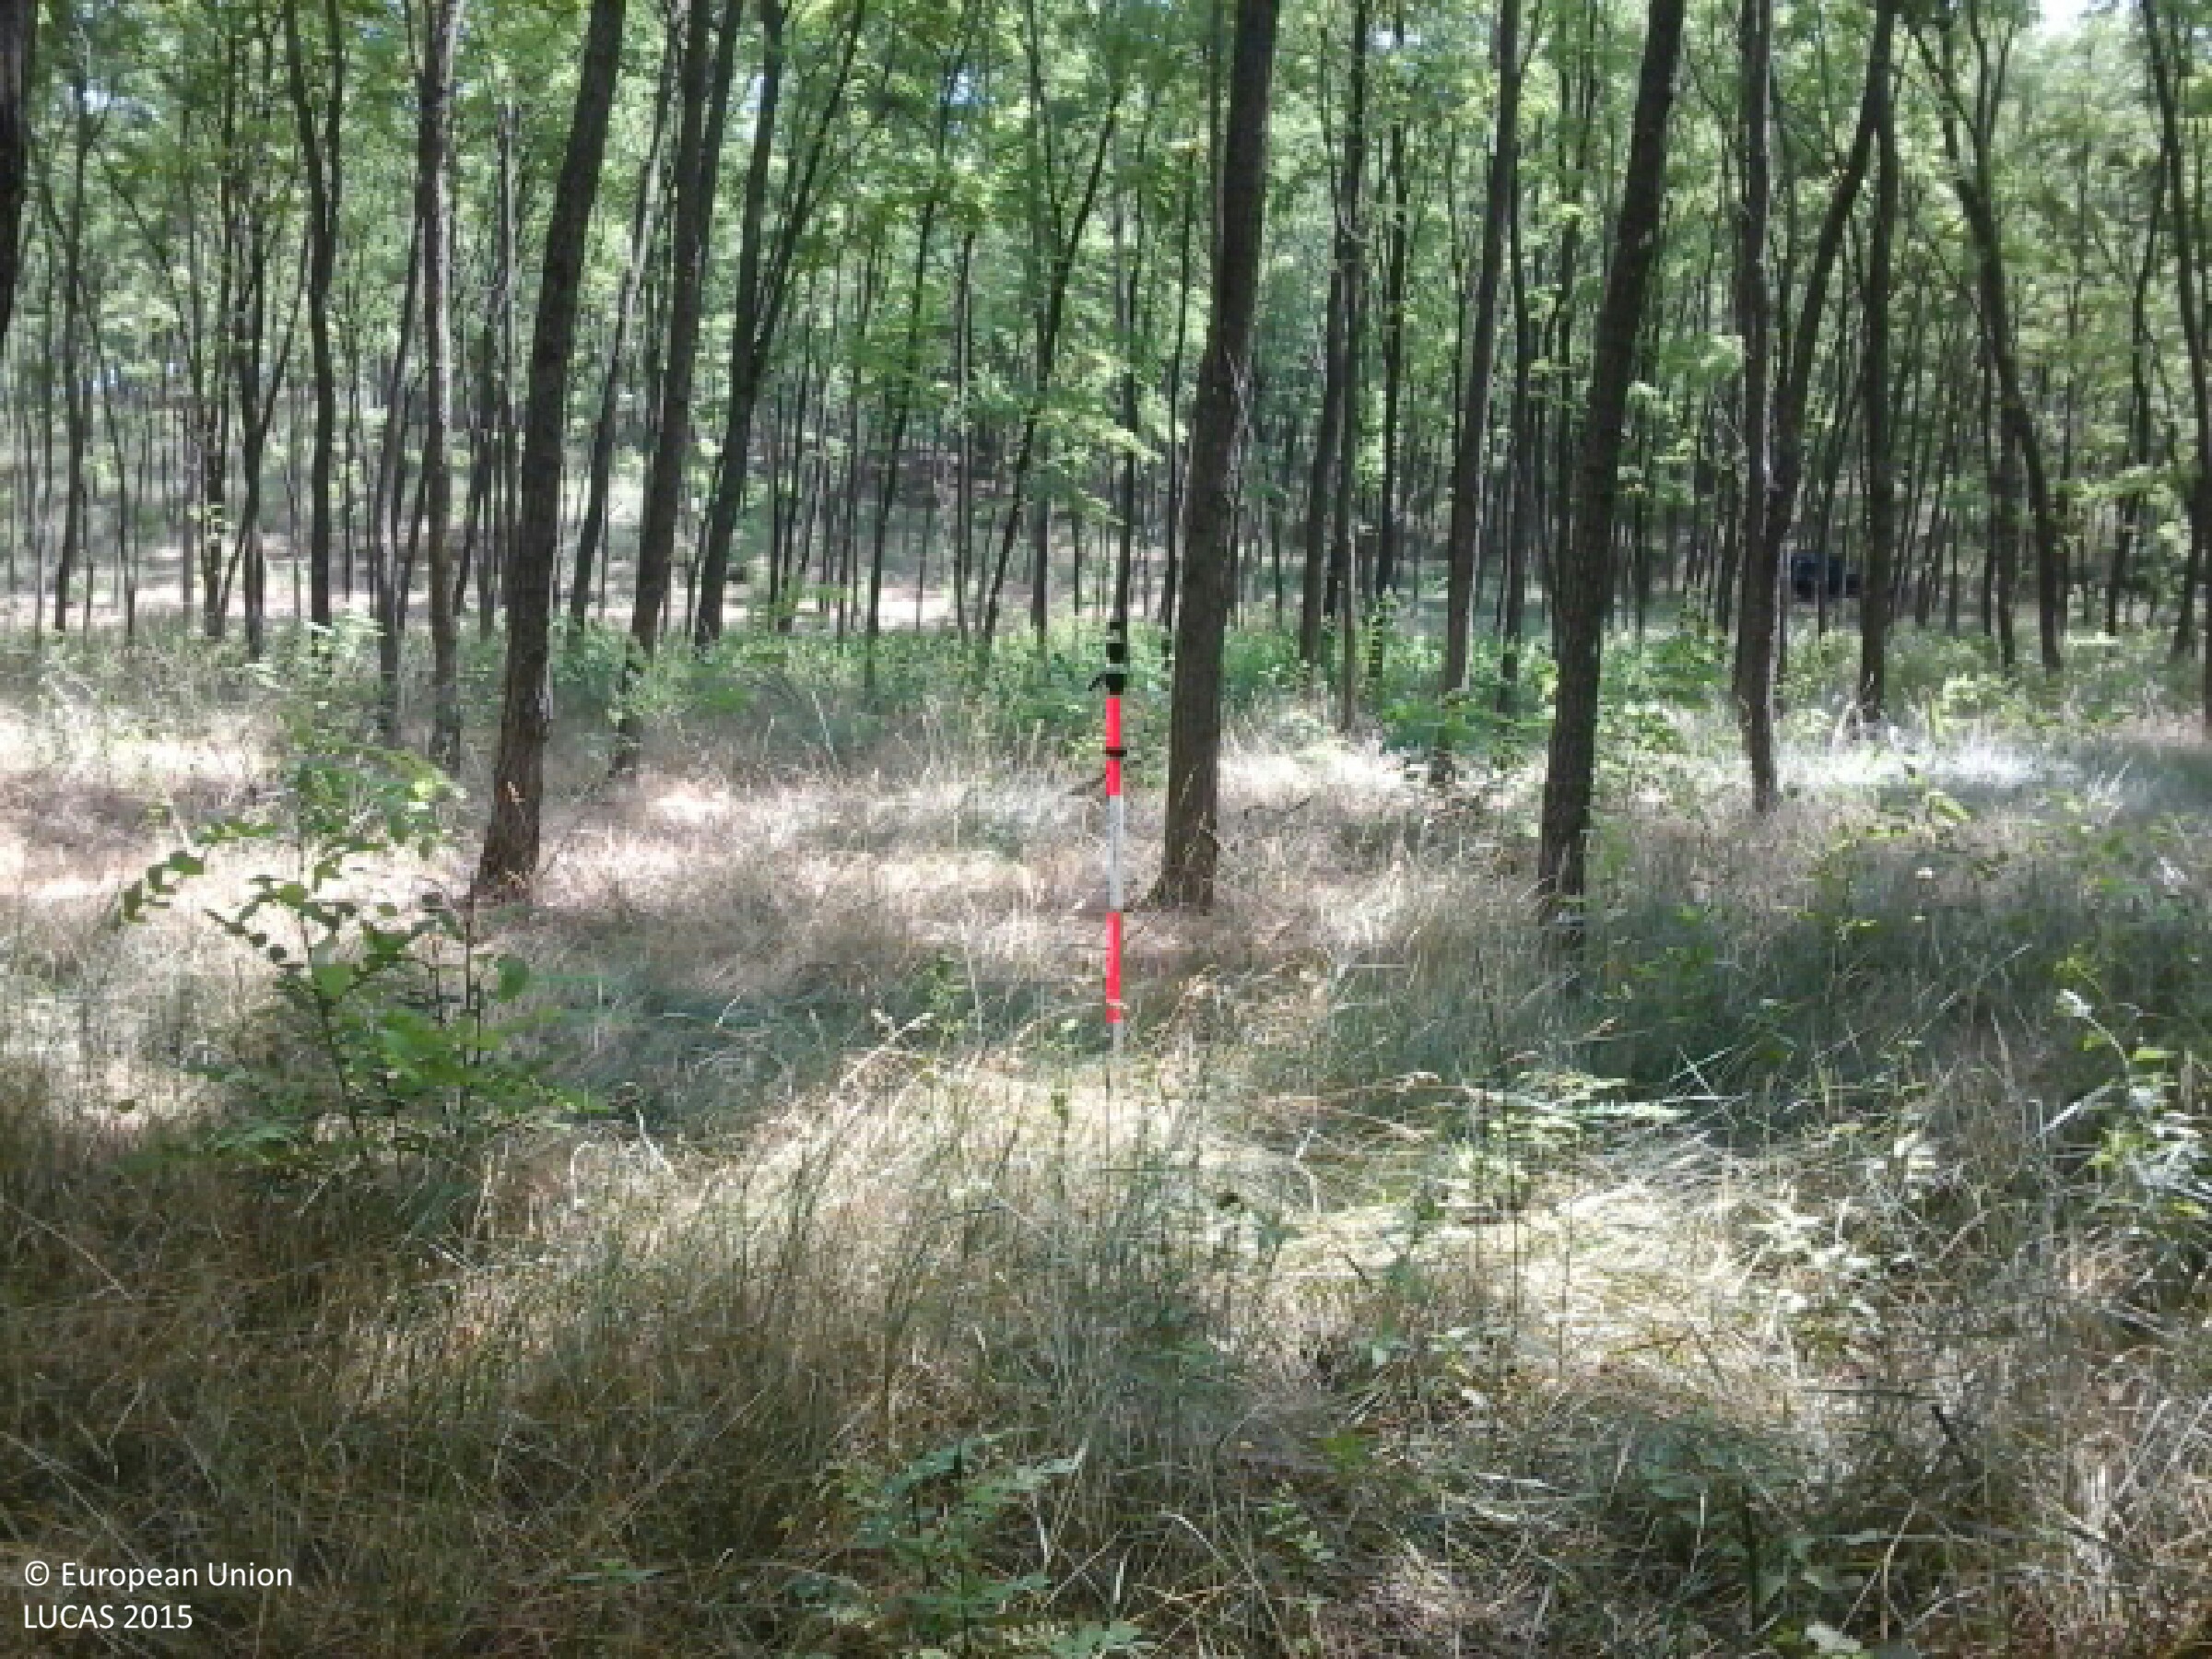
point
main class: Woodland
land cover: Broadleaved woodland
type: mesophytic deciduous forest
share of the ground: > 75 %
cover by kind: broadleaved forest trees 95 %, herbaceous plants 5 %
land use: Forestry
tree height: > 5 m
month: June
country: HU
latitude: 48.0794
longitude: 22.1216
